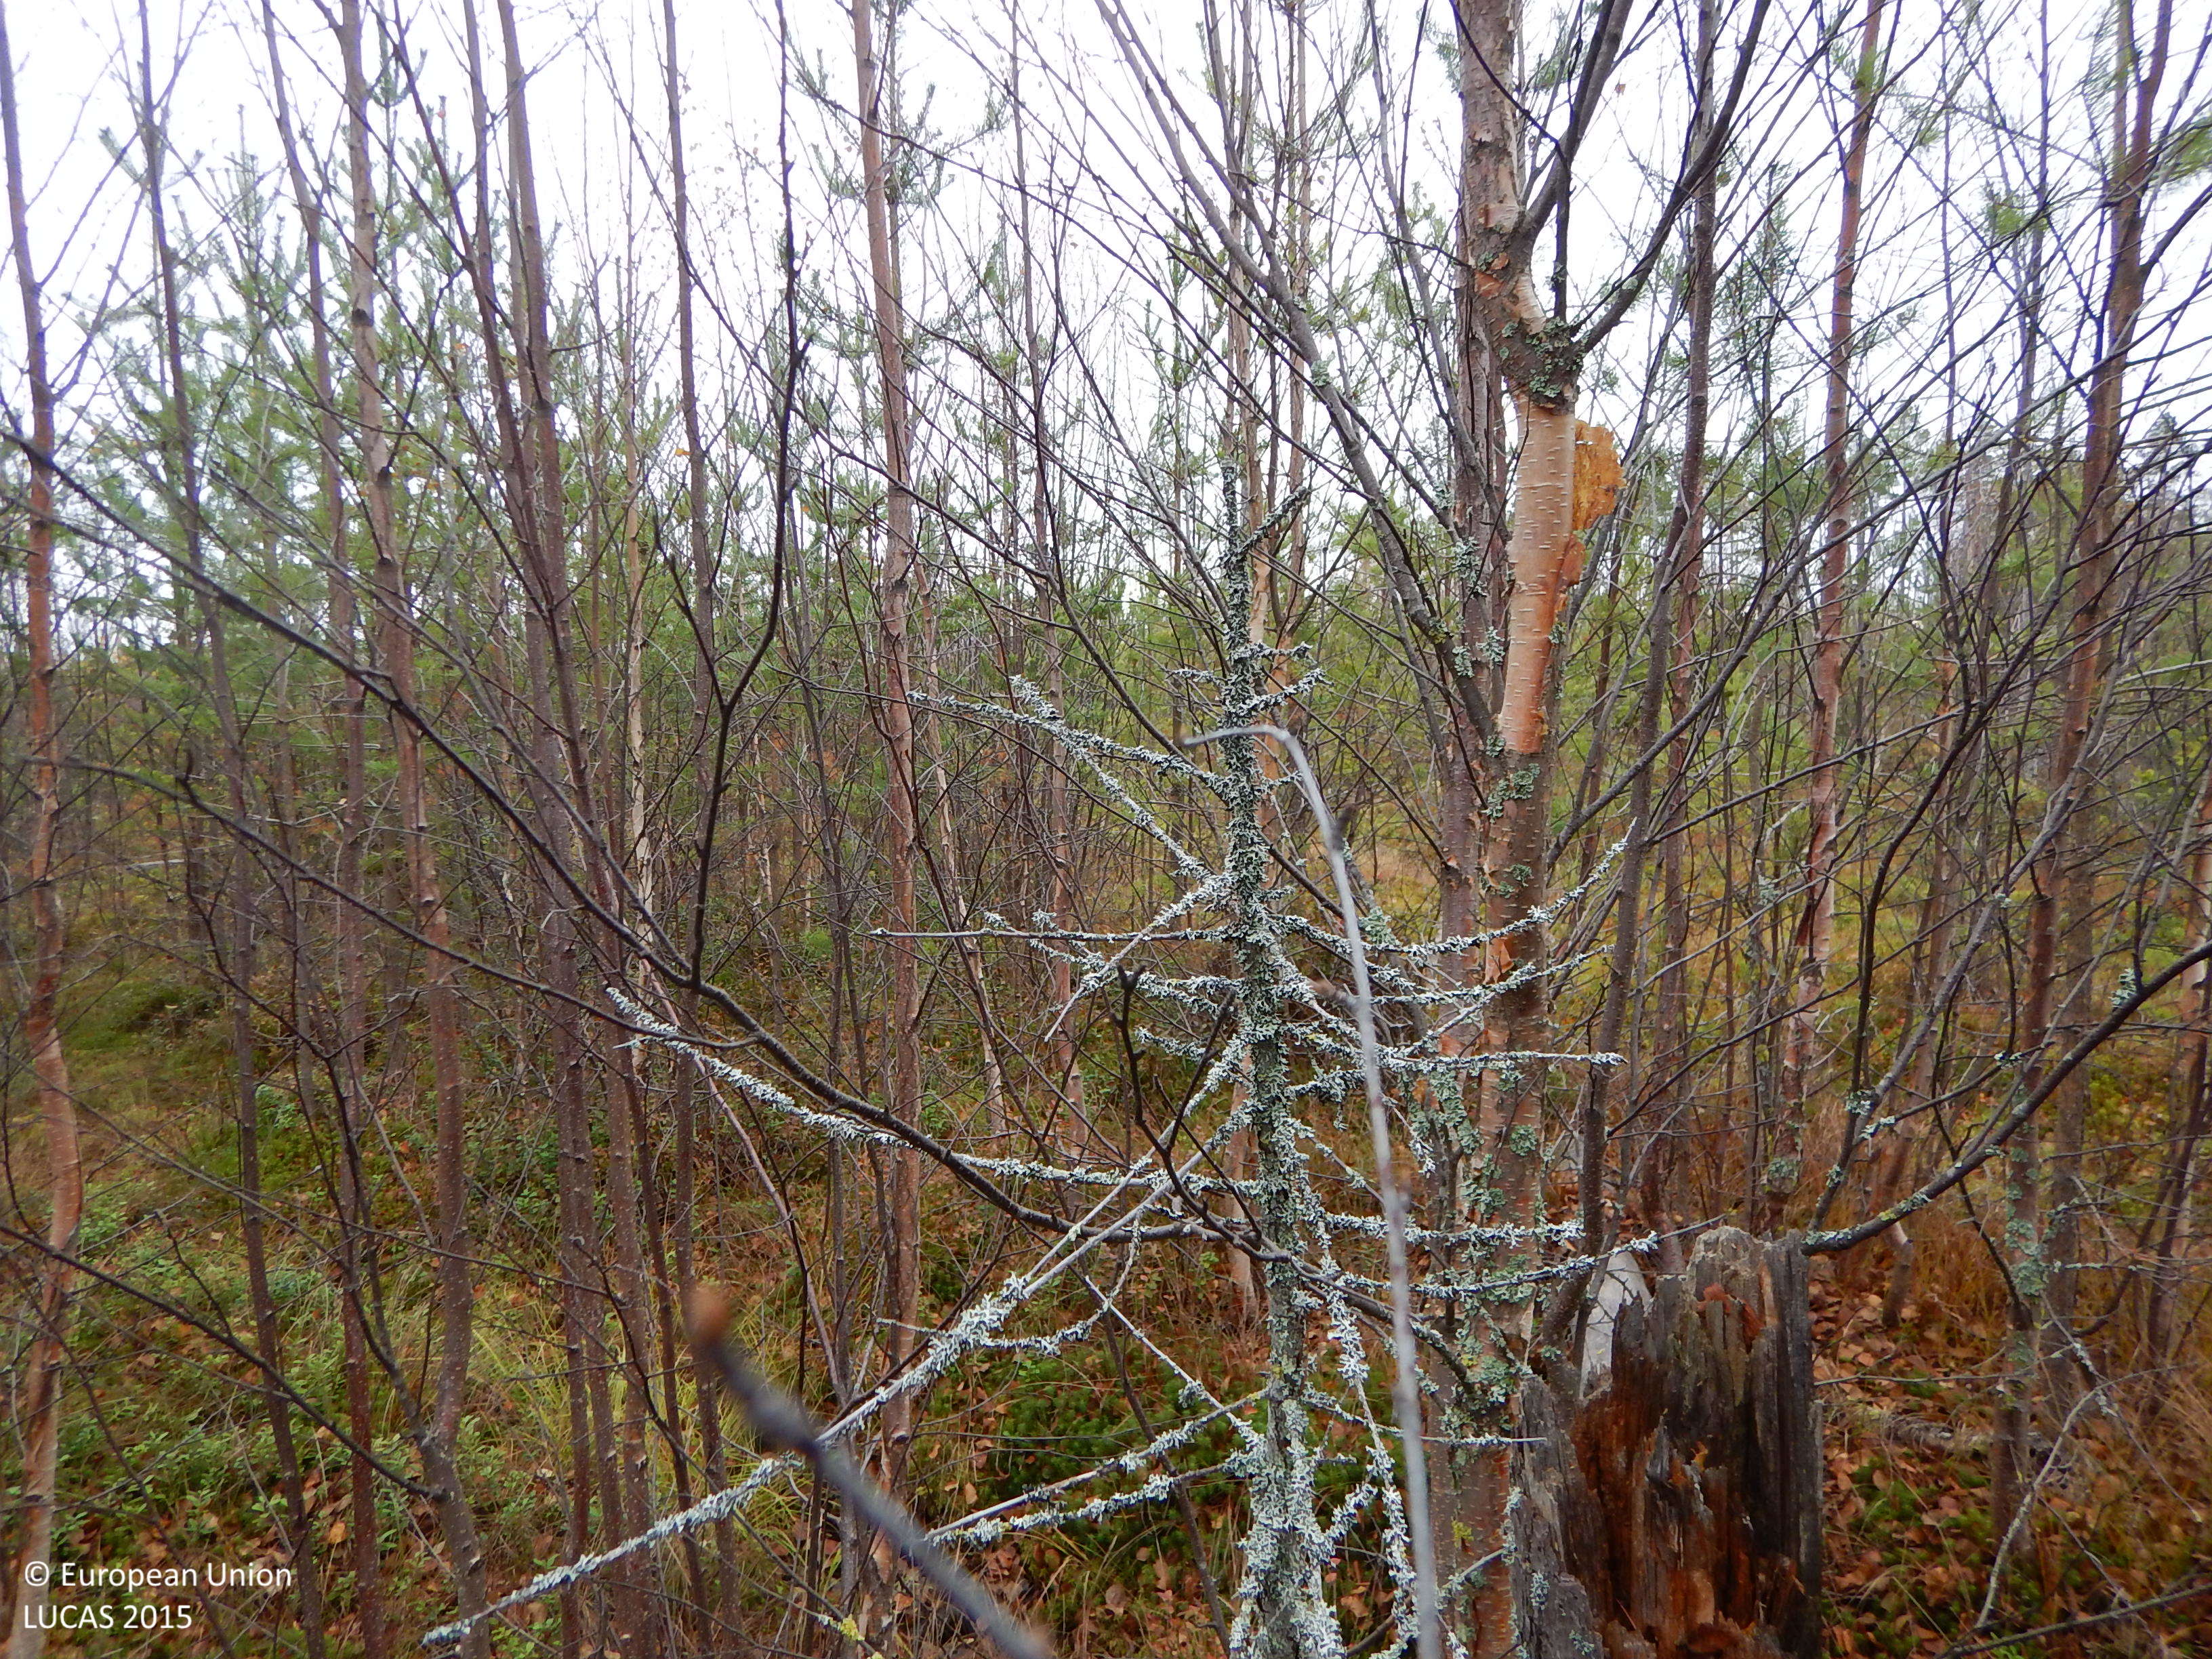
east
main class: Woodland
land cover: Other mixed woodland
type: boreal forest
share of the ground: 50 - 75 %
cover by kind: coniferous forest trees 30 %, broadleaved forest trees 20 %, shrubs 20 %, lichens and mosses 20 %, herbaceous plants 10 %
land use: Forestry
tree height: < 5 m
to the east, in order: Other mixed woodland; Pine dominated mixed woodland; Other mixed woodland
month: October
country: SE
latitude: 64.9558
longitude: 21.1348
